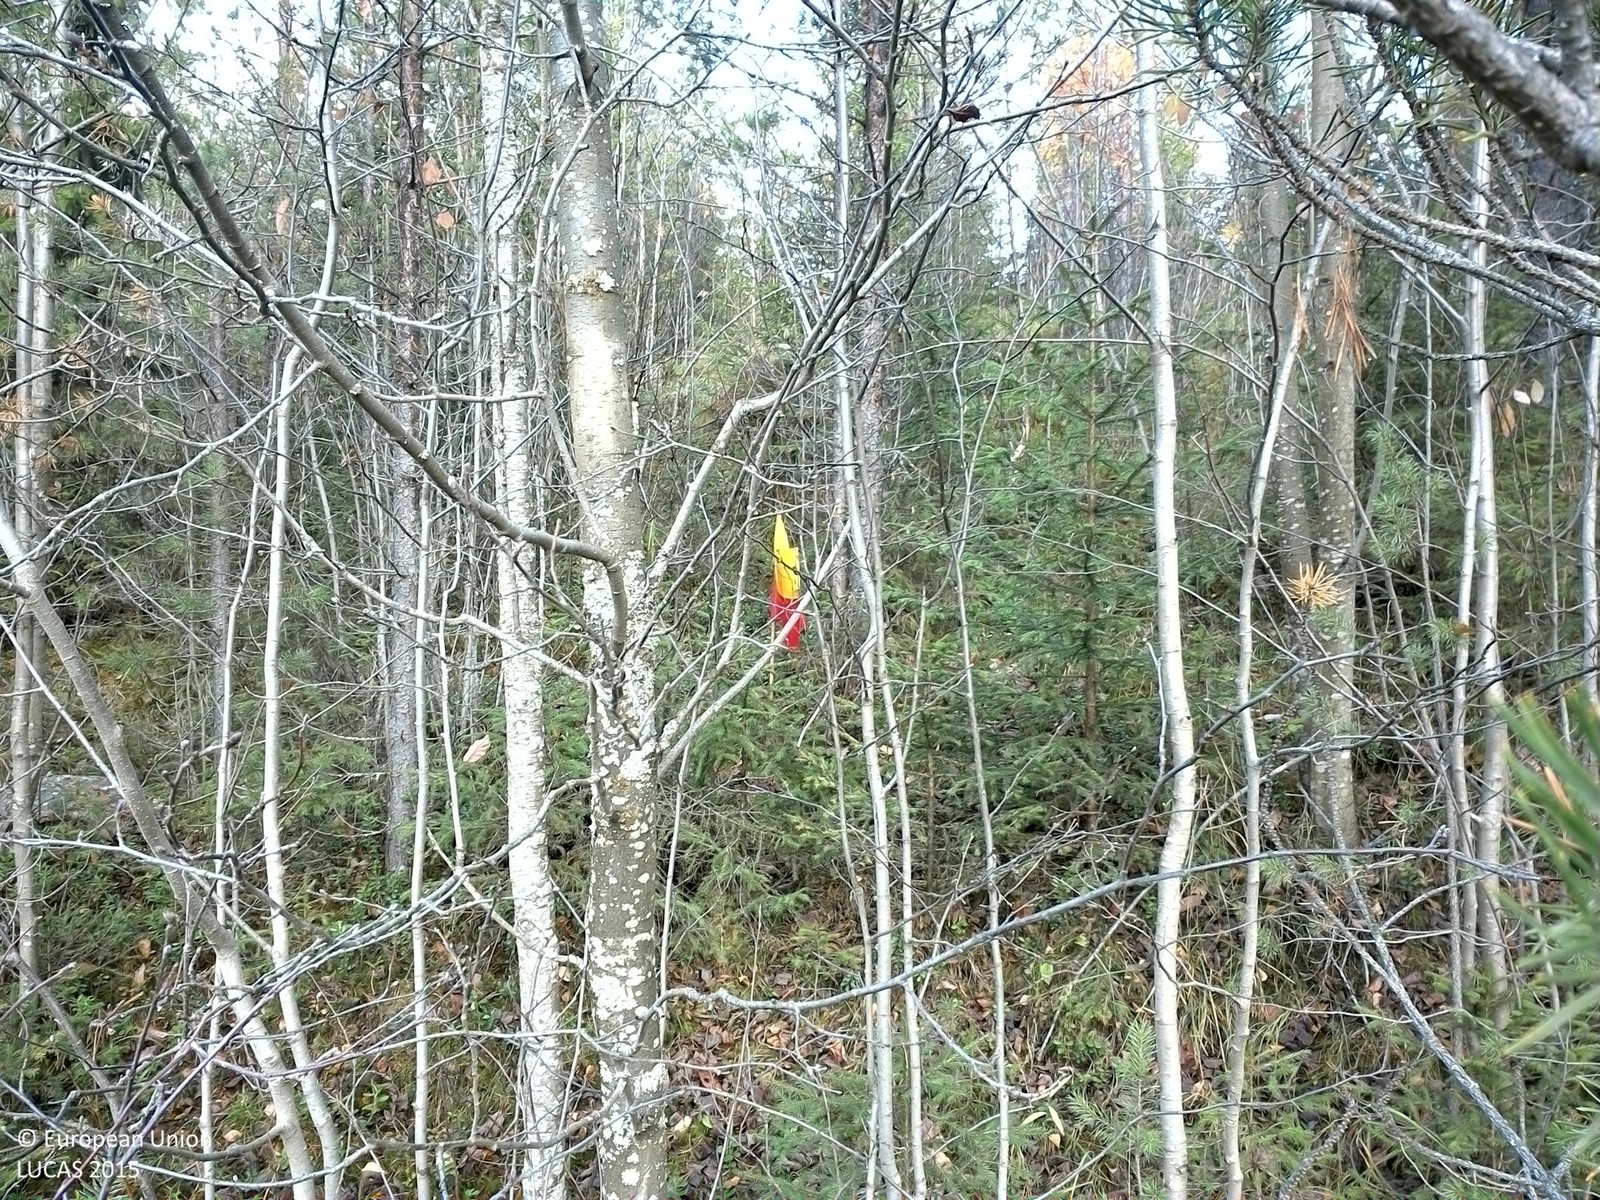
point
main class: Woodland
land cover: Pine dominated mixed woodland
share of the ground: 50 - 75 %
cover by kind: coniferous forest trees 35 %, shrubs 30 %, broadleaved forest trees 20 %, lichens and mosses 10 %, herbaceous plants 5 %
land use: Forestry
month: October
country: SE
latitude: 64.1011
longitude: 16.0653
